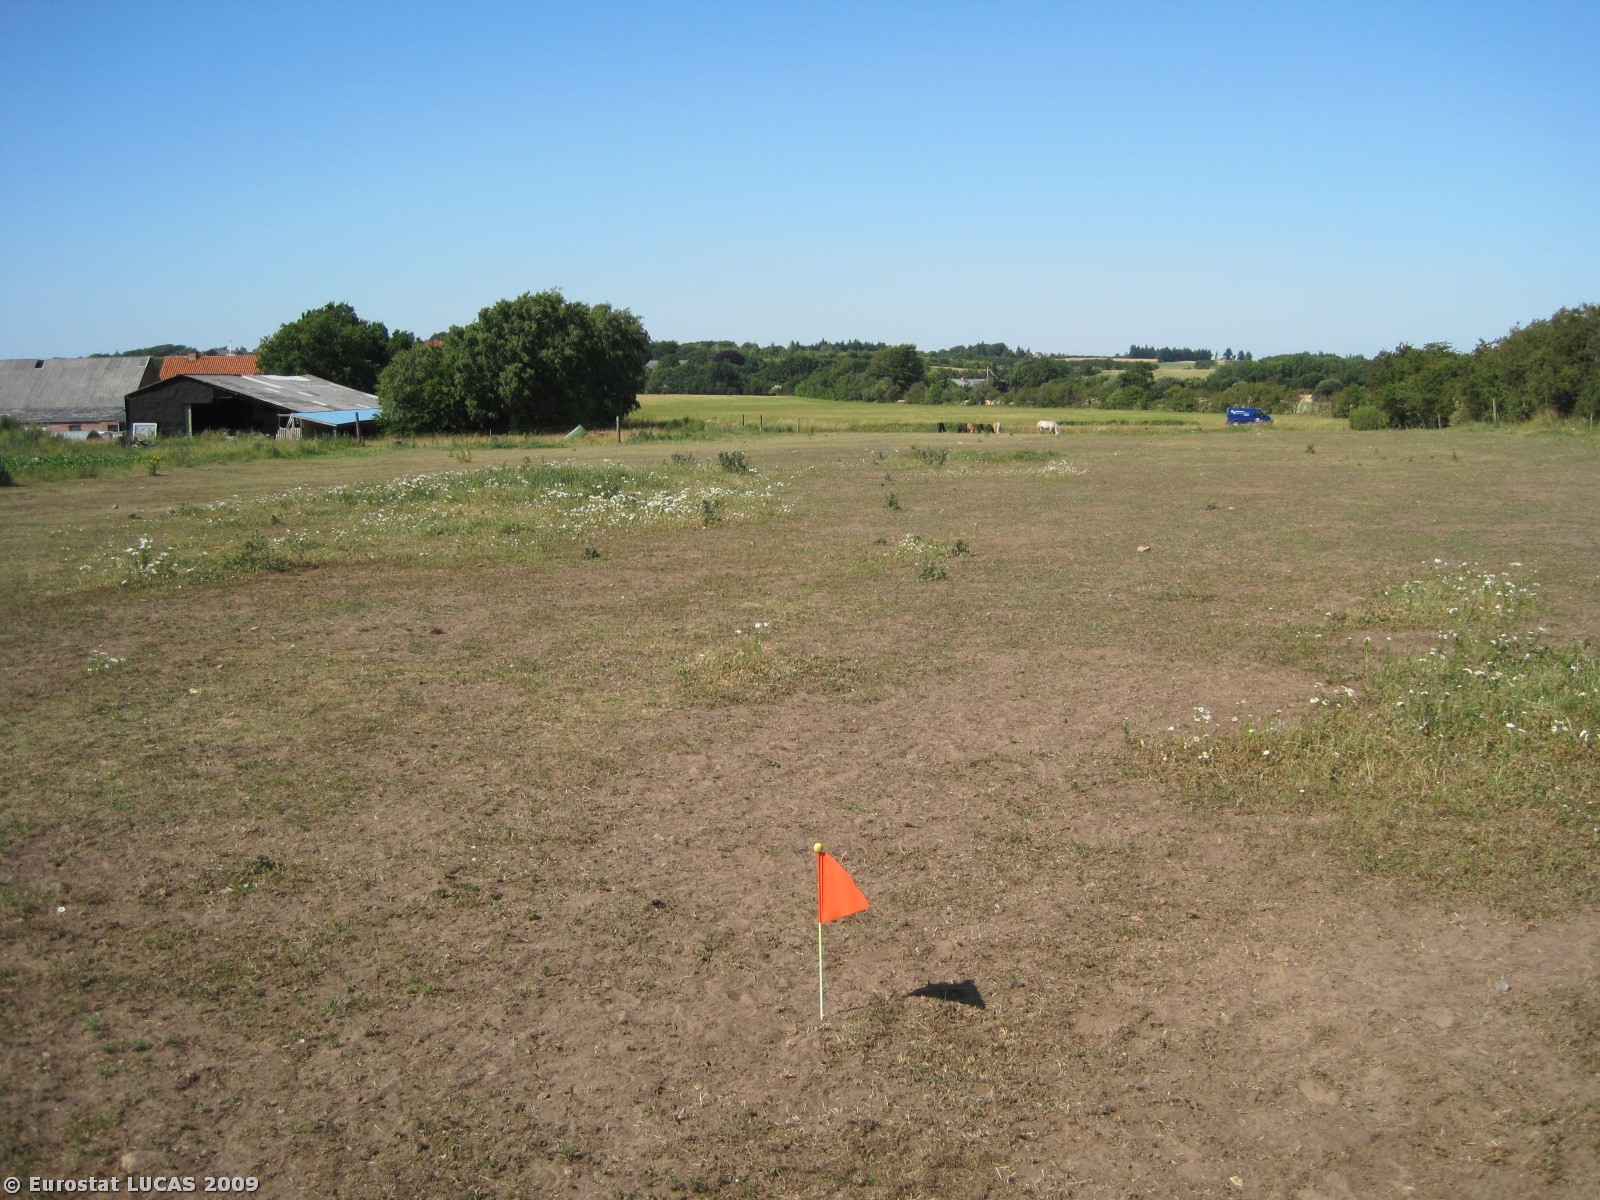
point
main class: Grassland
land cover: Grassland without tree/shrub cover
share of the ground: > 75 %
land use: Agriculture (excluding fallow land and kitchen gardens)
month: July
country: DK
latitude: 56.4127
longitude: 8.4945
